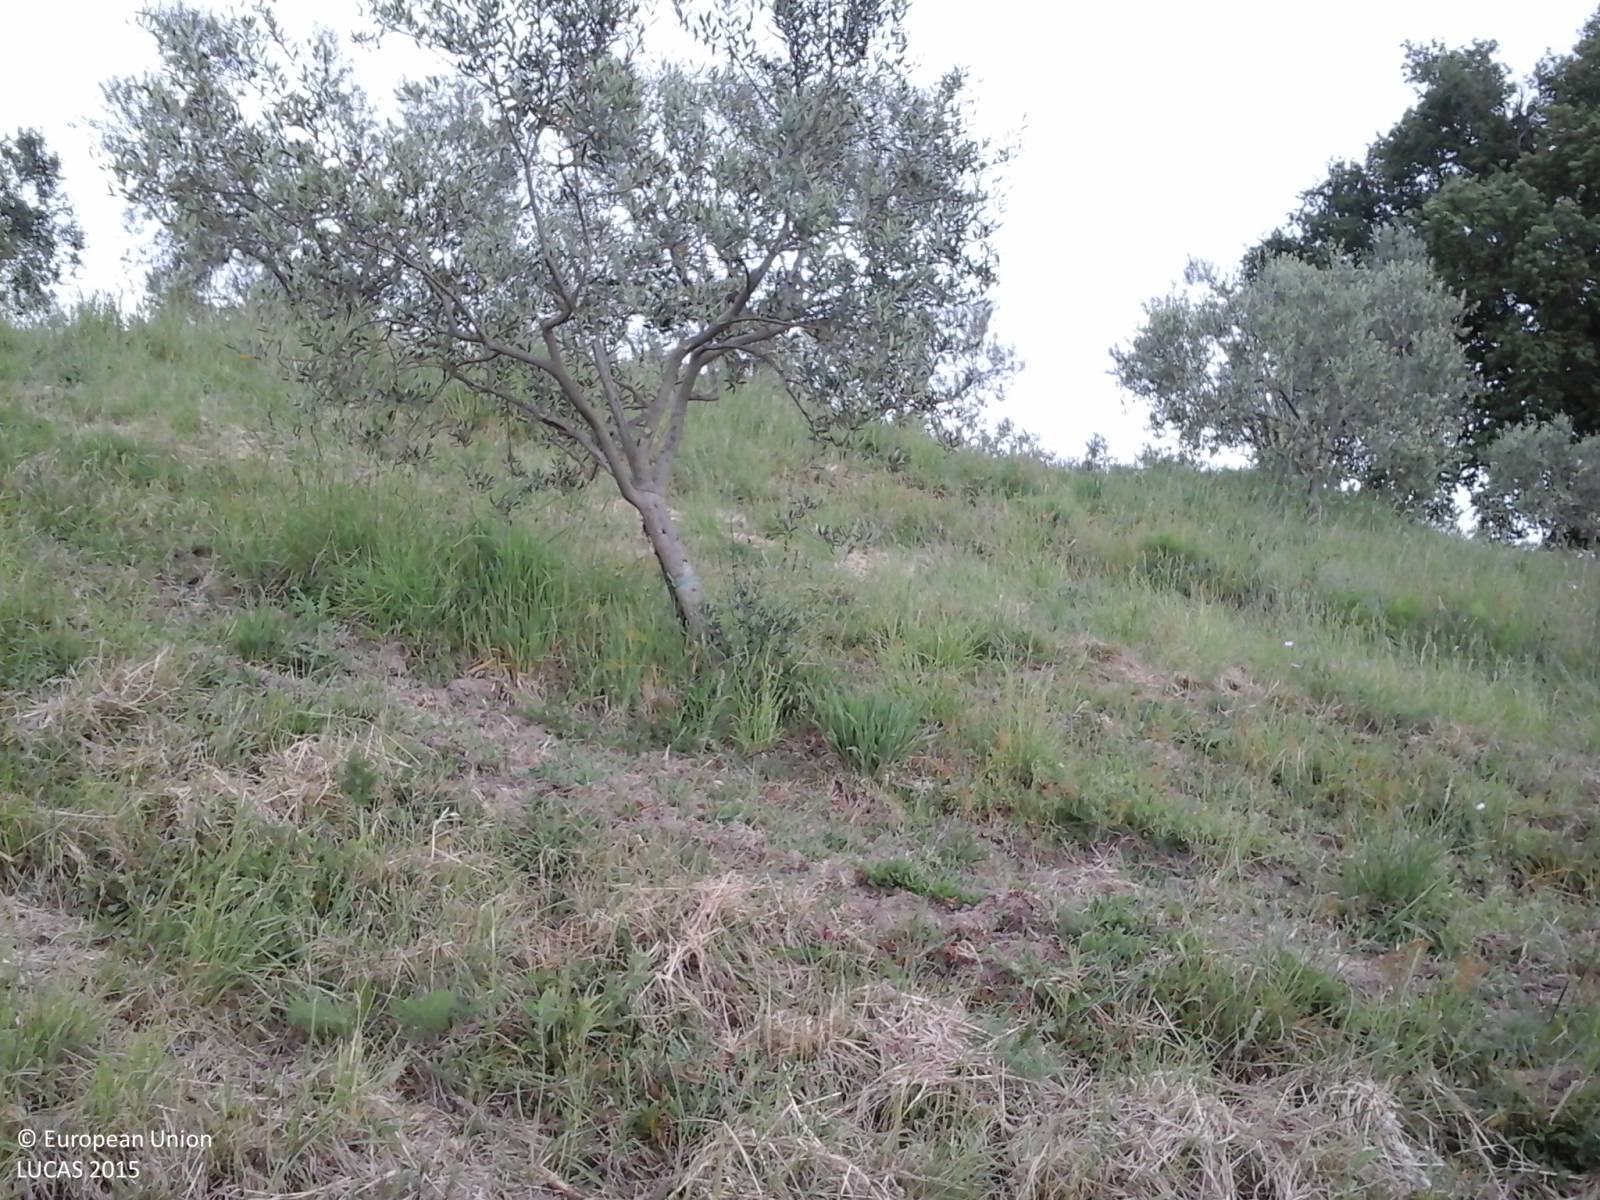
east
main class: Cropland
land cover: Olive groves
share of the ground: 25 - 50 %
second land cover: Grassland without tree/shrub cover
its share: > 75 %
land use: Agriculture (excluding fallow land and kitchen gardens)
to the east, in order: Olive groves; Grassland without tree/shrub cover; Ditches and canals; Durum wheat; Fences; Olive groves; Artificial constructions in urban areas
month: May
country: IT
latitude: 42.5610
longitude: 12.0517
